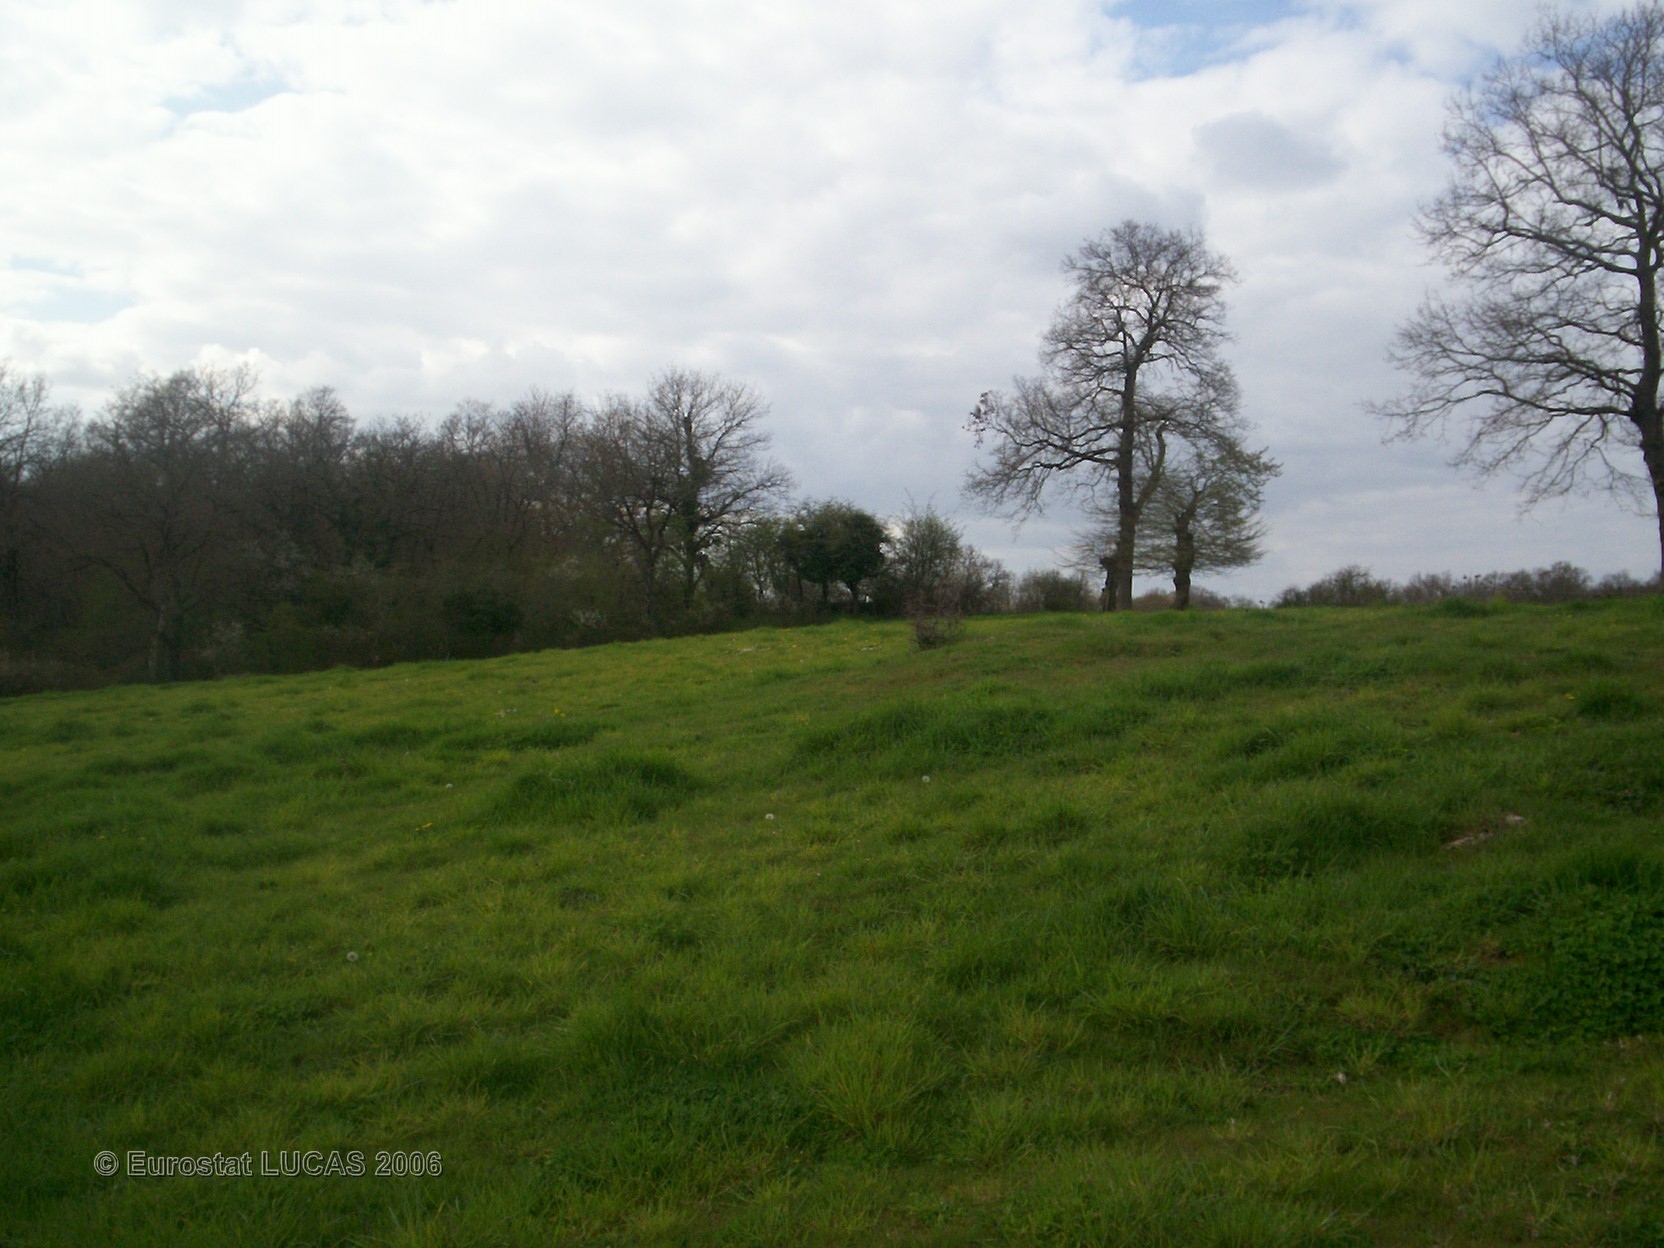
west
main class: Grassland
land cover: Grassland without tree/shrub cover
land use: Agriculture (excluding fallow land and kitchen gardens)
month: April
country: FR
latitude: 46.4302
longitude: 1.0728
